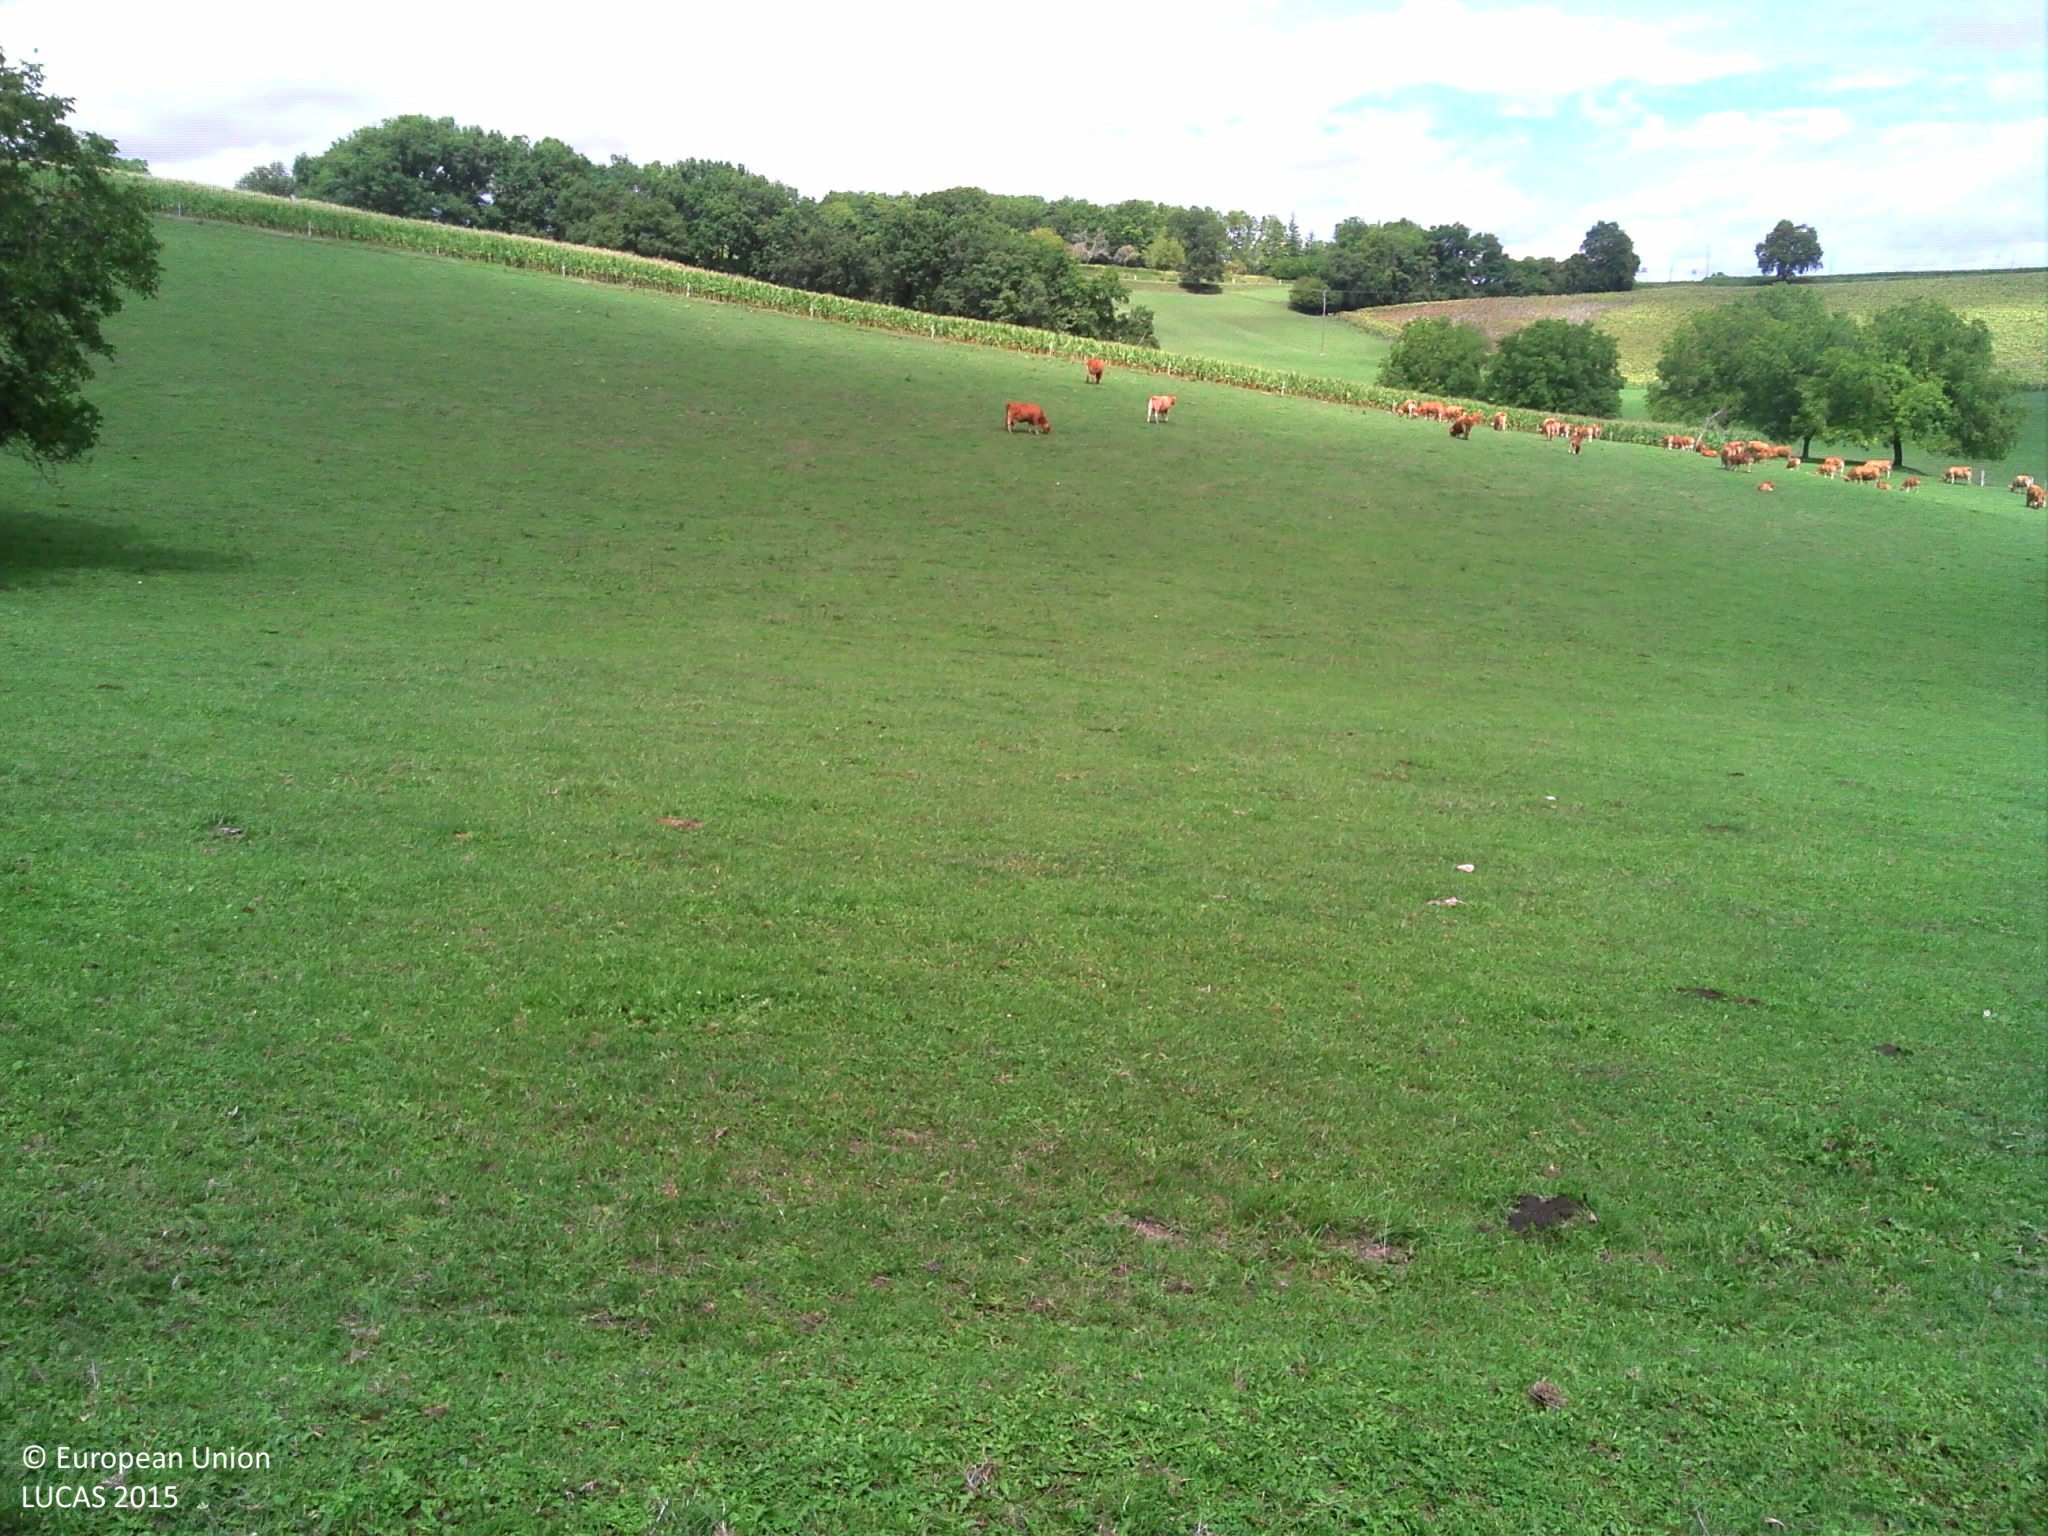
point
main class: Grassland
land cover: Grassland without tree/shrub cover
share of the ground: > 75 %
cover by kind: herbaceous plants 80 %, lichens and mosses 20 %
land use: Agriculture (excluding fallow land and kitchen gardens)
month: August
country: FR
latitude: 45.2918
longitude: 0.4887
